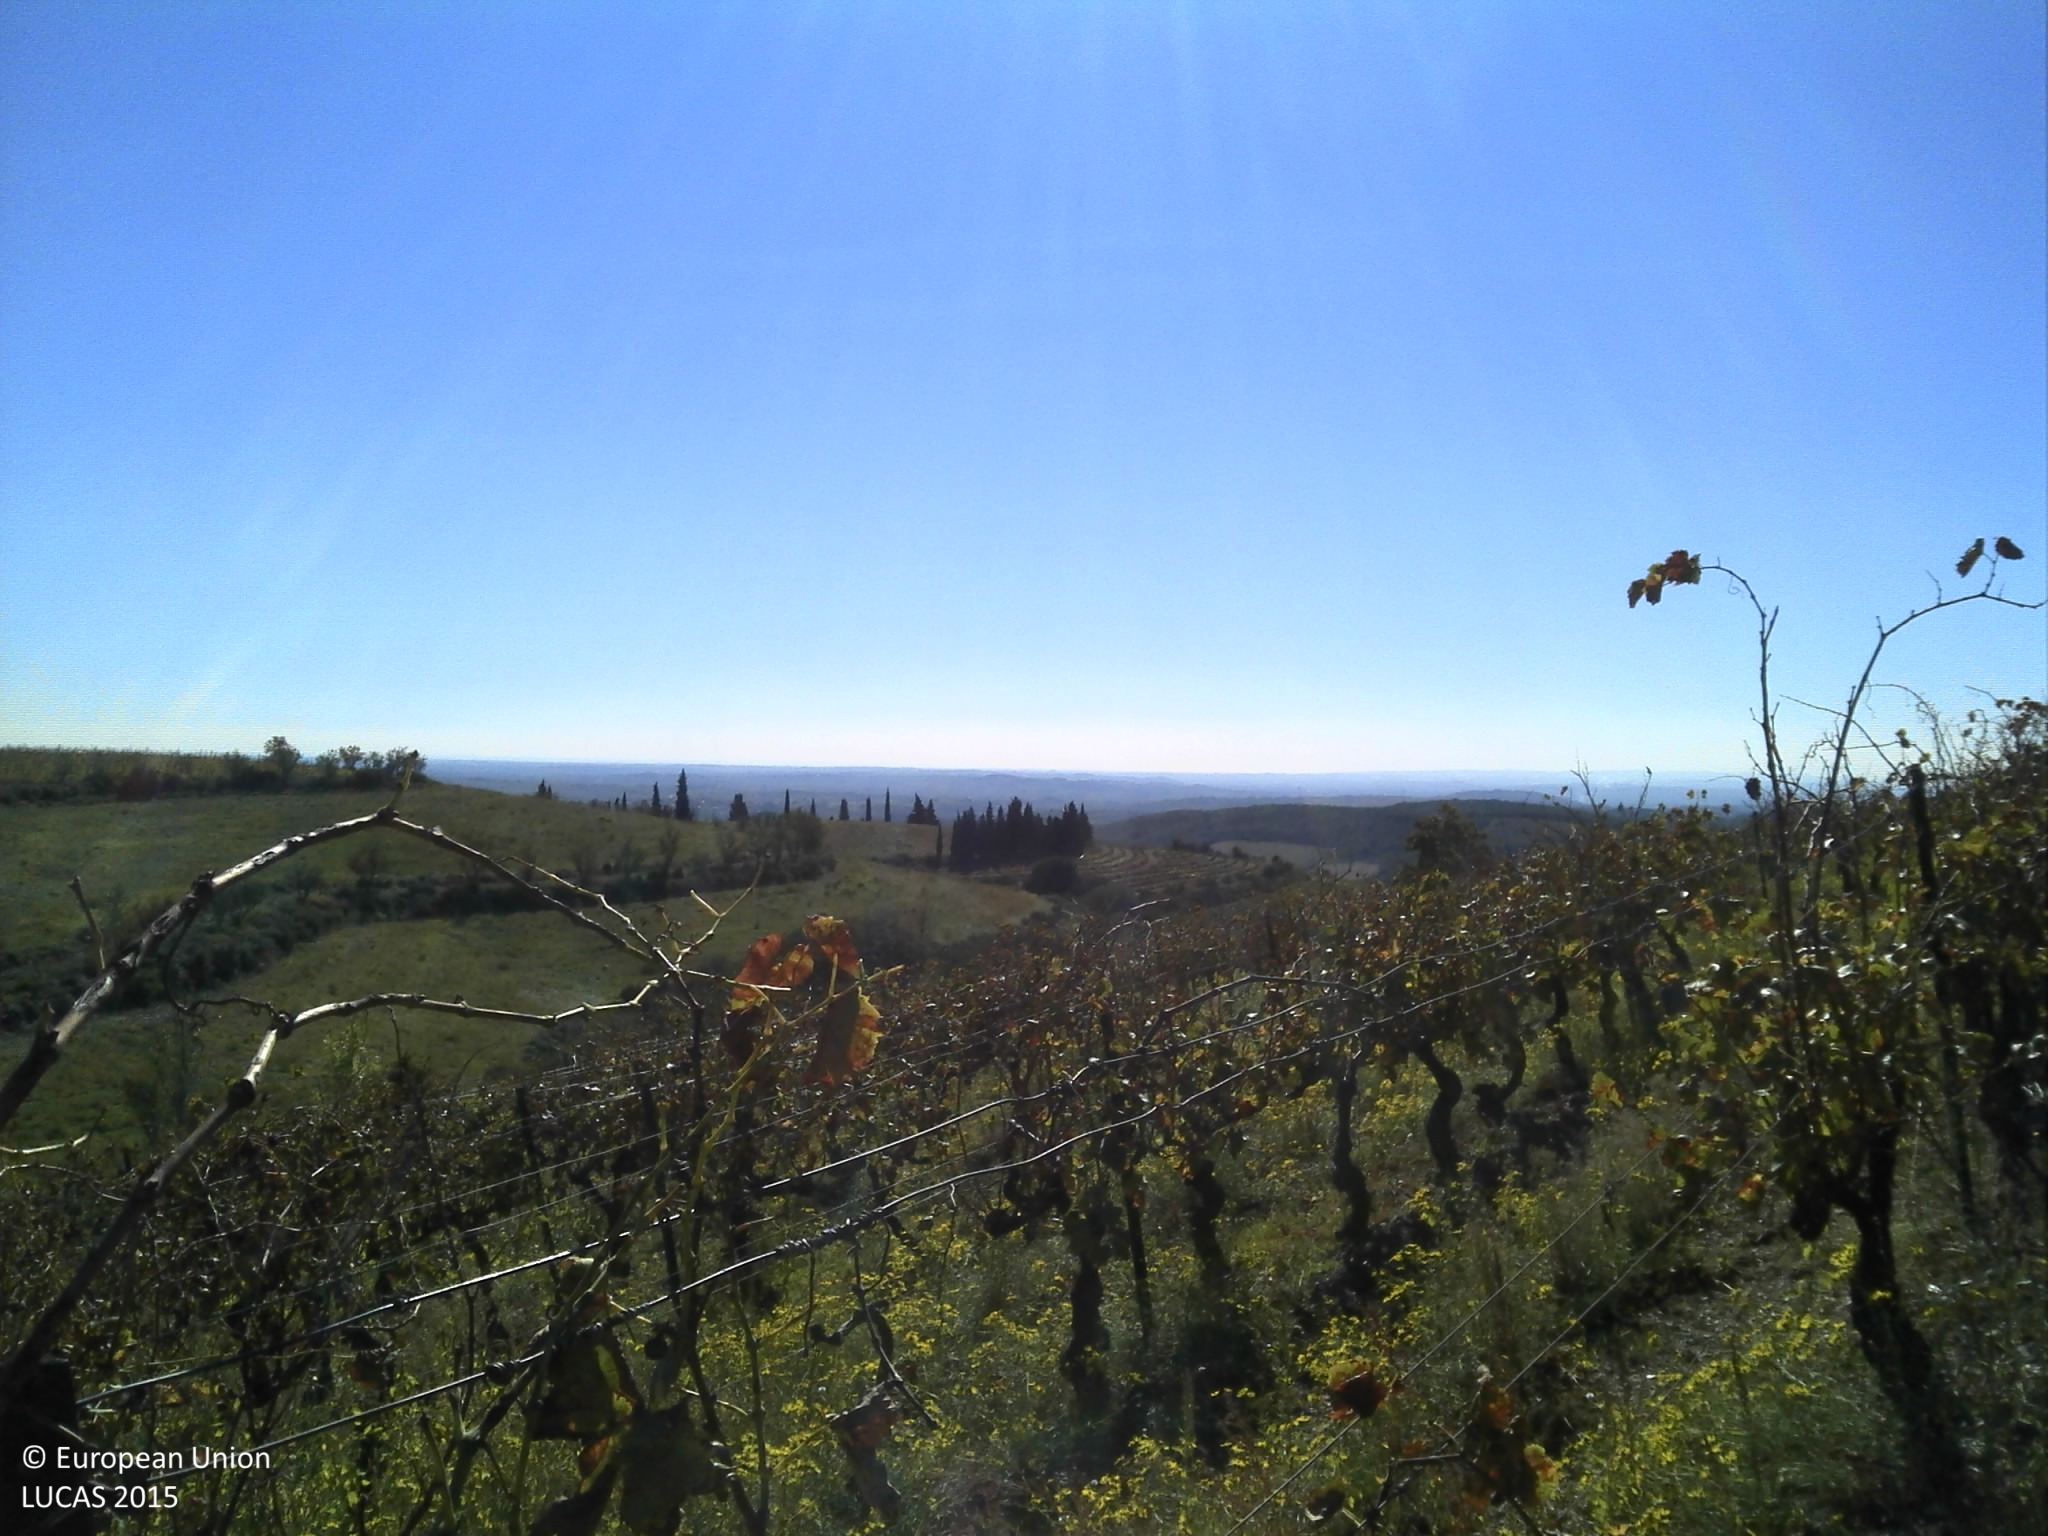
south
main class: Cropland
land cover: Vineyards
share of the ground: 10 - 25 %
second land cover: Spontaneously vegetated surfaces
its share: 50 - 75 %
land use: Agriculture (excluding fallow land and kitchen gardens)
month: October
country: FR
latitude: 43.5442
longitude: 3.1394
